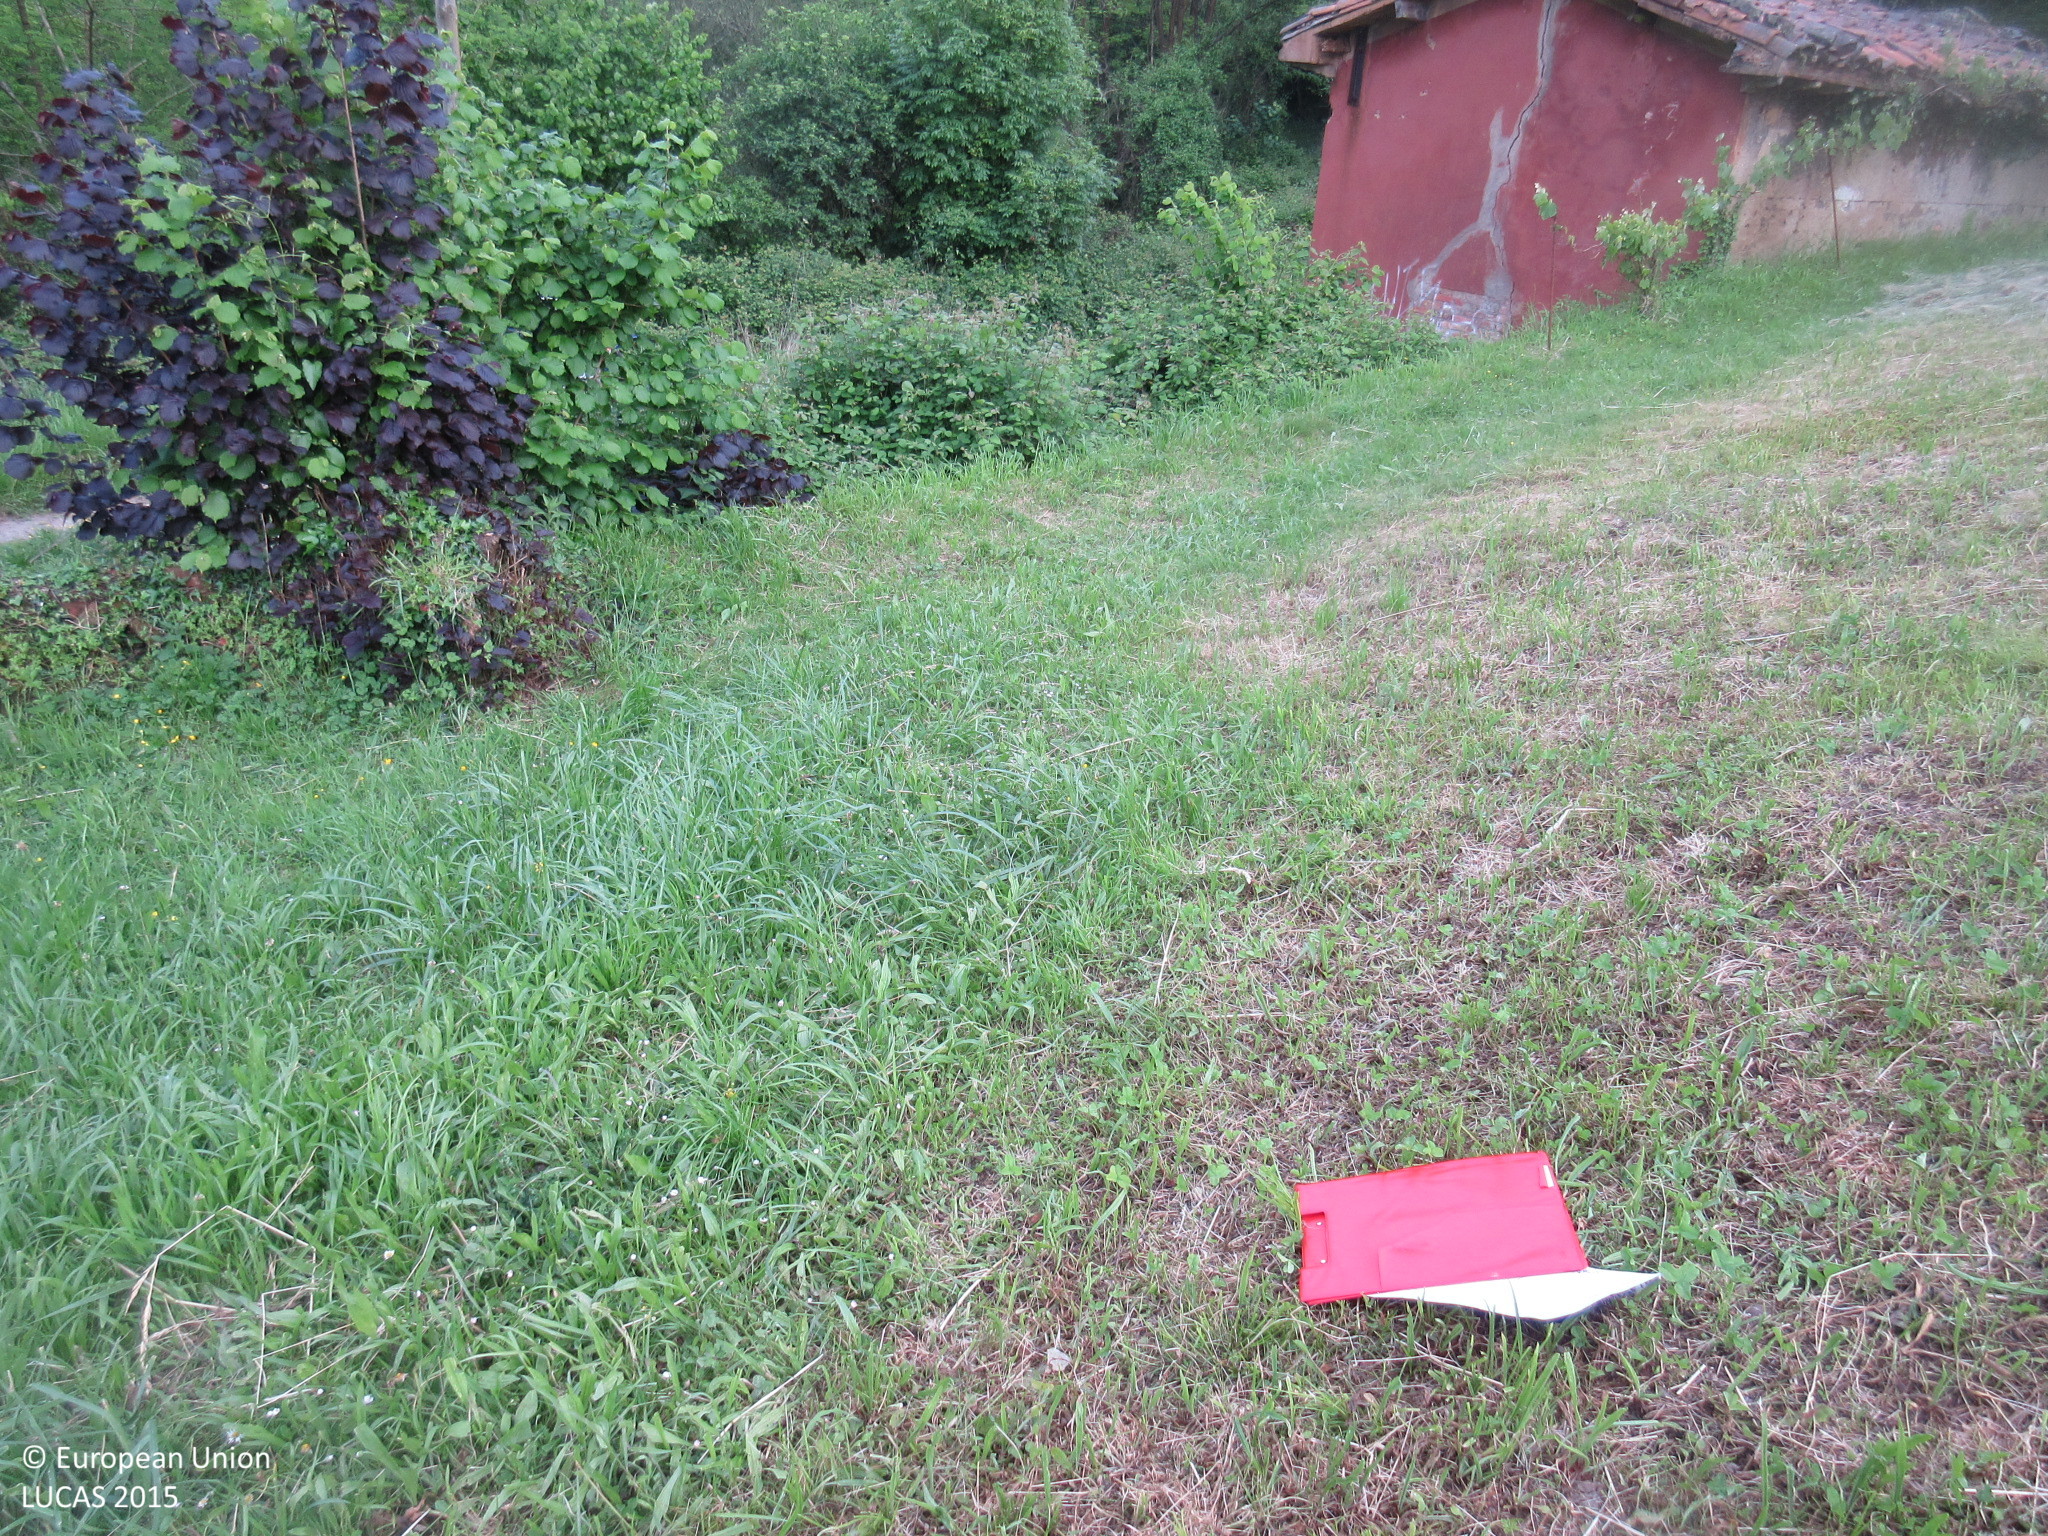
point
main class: Grassland
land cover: Grassland without tree/shrub cover
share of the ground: > 75 %
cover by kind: herbaceous plants 100 %
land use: Agriculture (excluding fallow land and kitchen gardens)
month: May
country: ES
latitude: 43.3083
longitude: -5.6033
